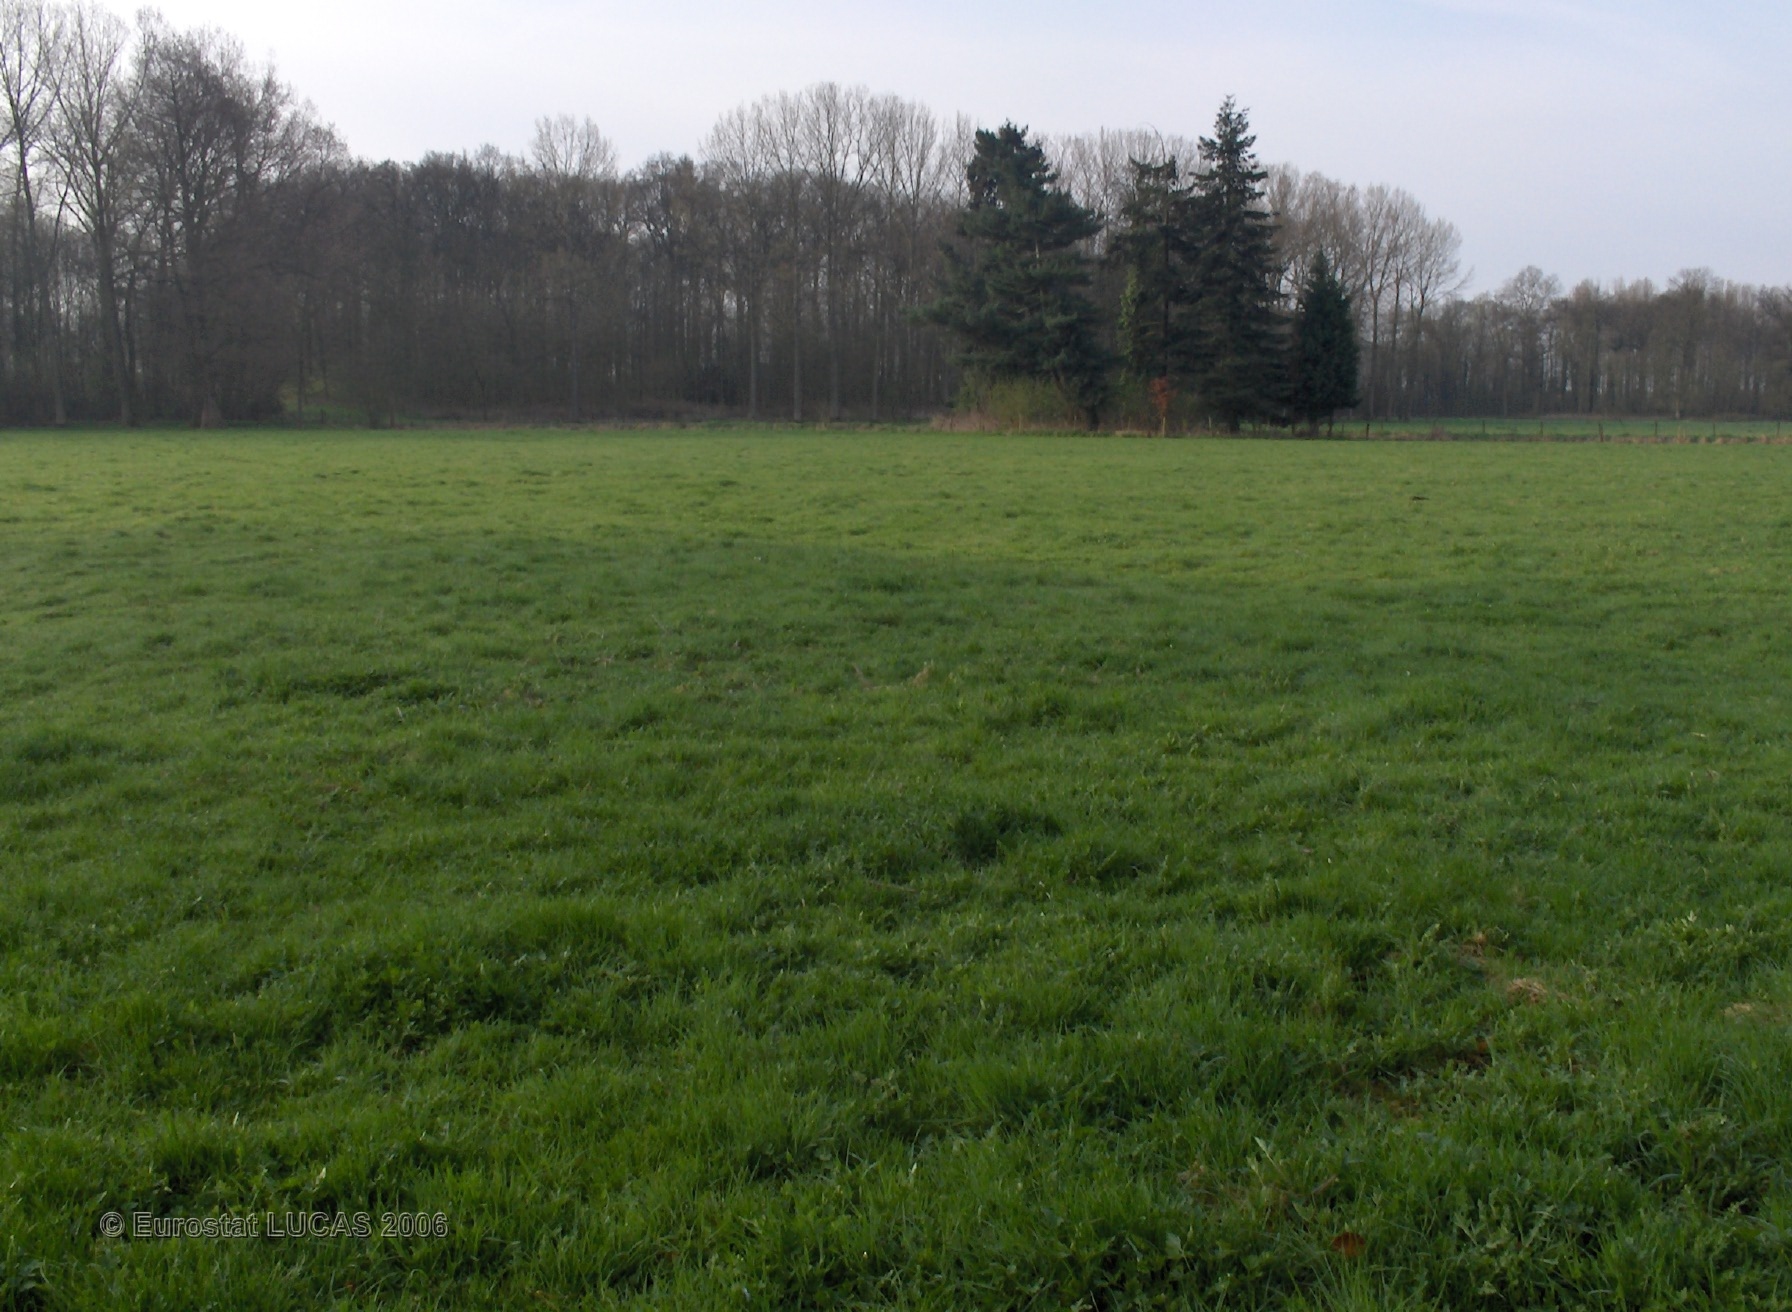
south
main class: Grassland
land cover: Grassland without tree/shrub cover
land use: Agriculture (excluding fallow land and kitchen gardens)
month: April
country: BE
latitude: 50.8391
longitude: 5.1835
